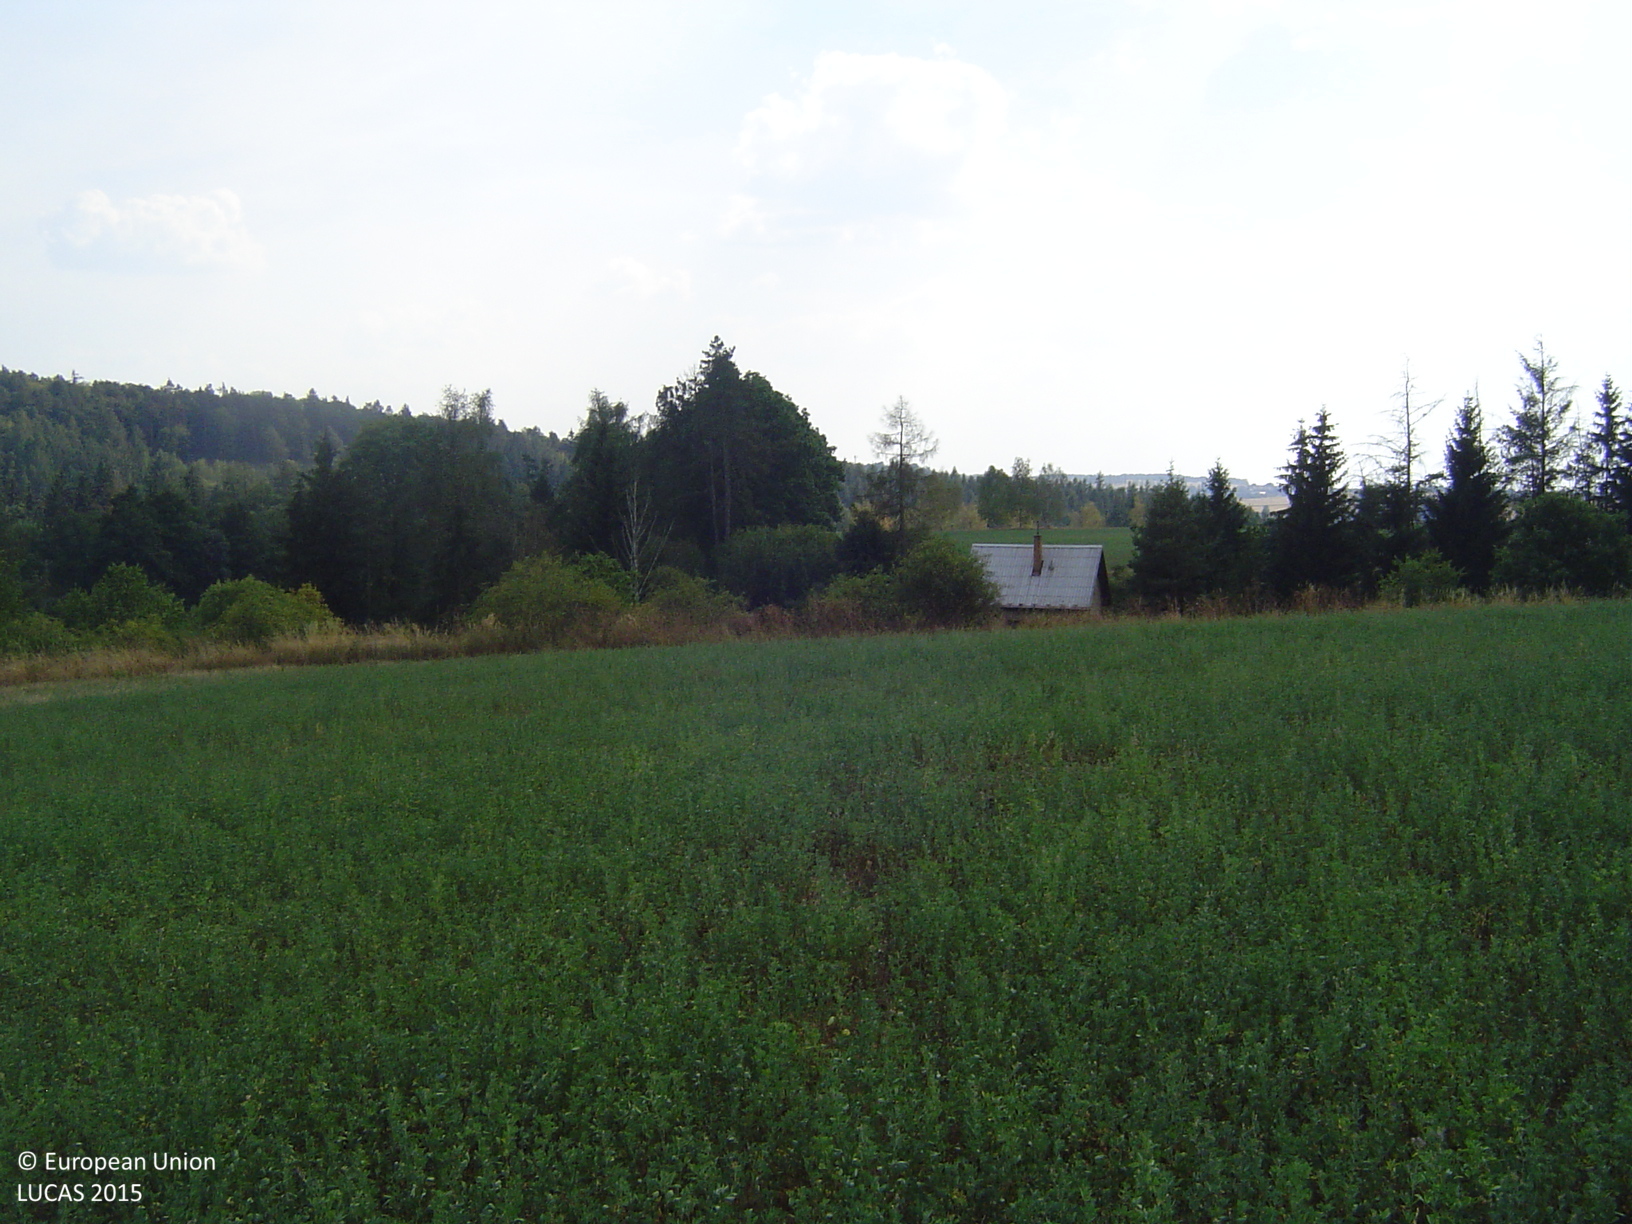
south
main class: Cropland
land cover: Lucerne
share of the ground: > 75 %
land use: Agriculture (excluding fallow land and kitchen gardens)
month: August
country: CZ
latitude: 50.0947
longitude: 14.0408
